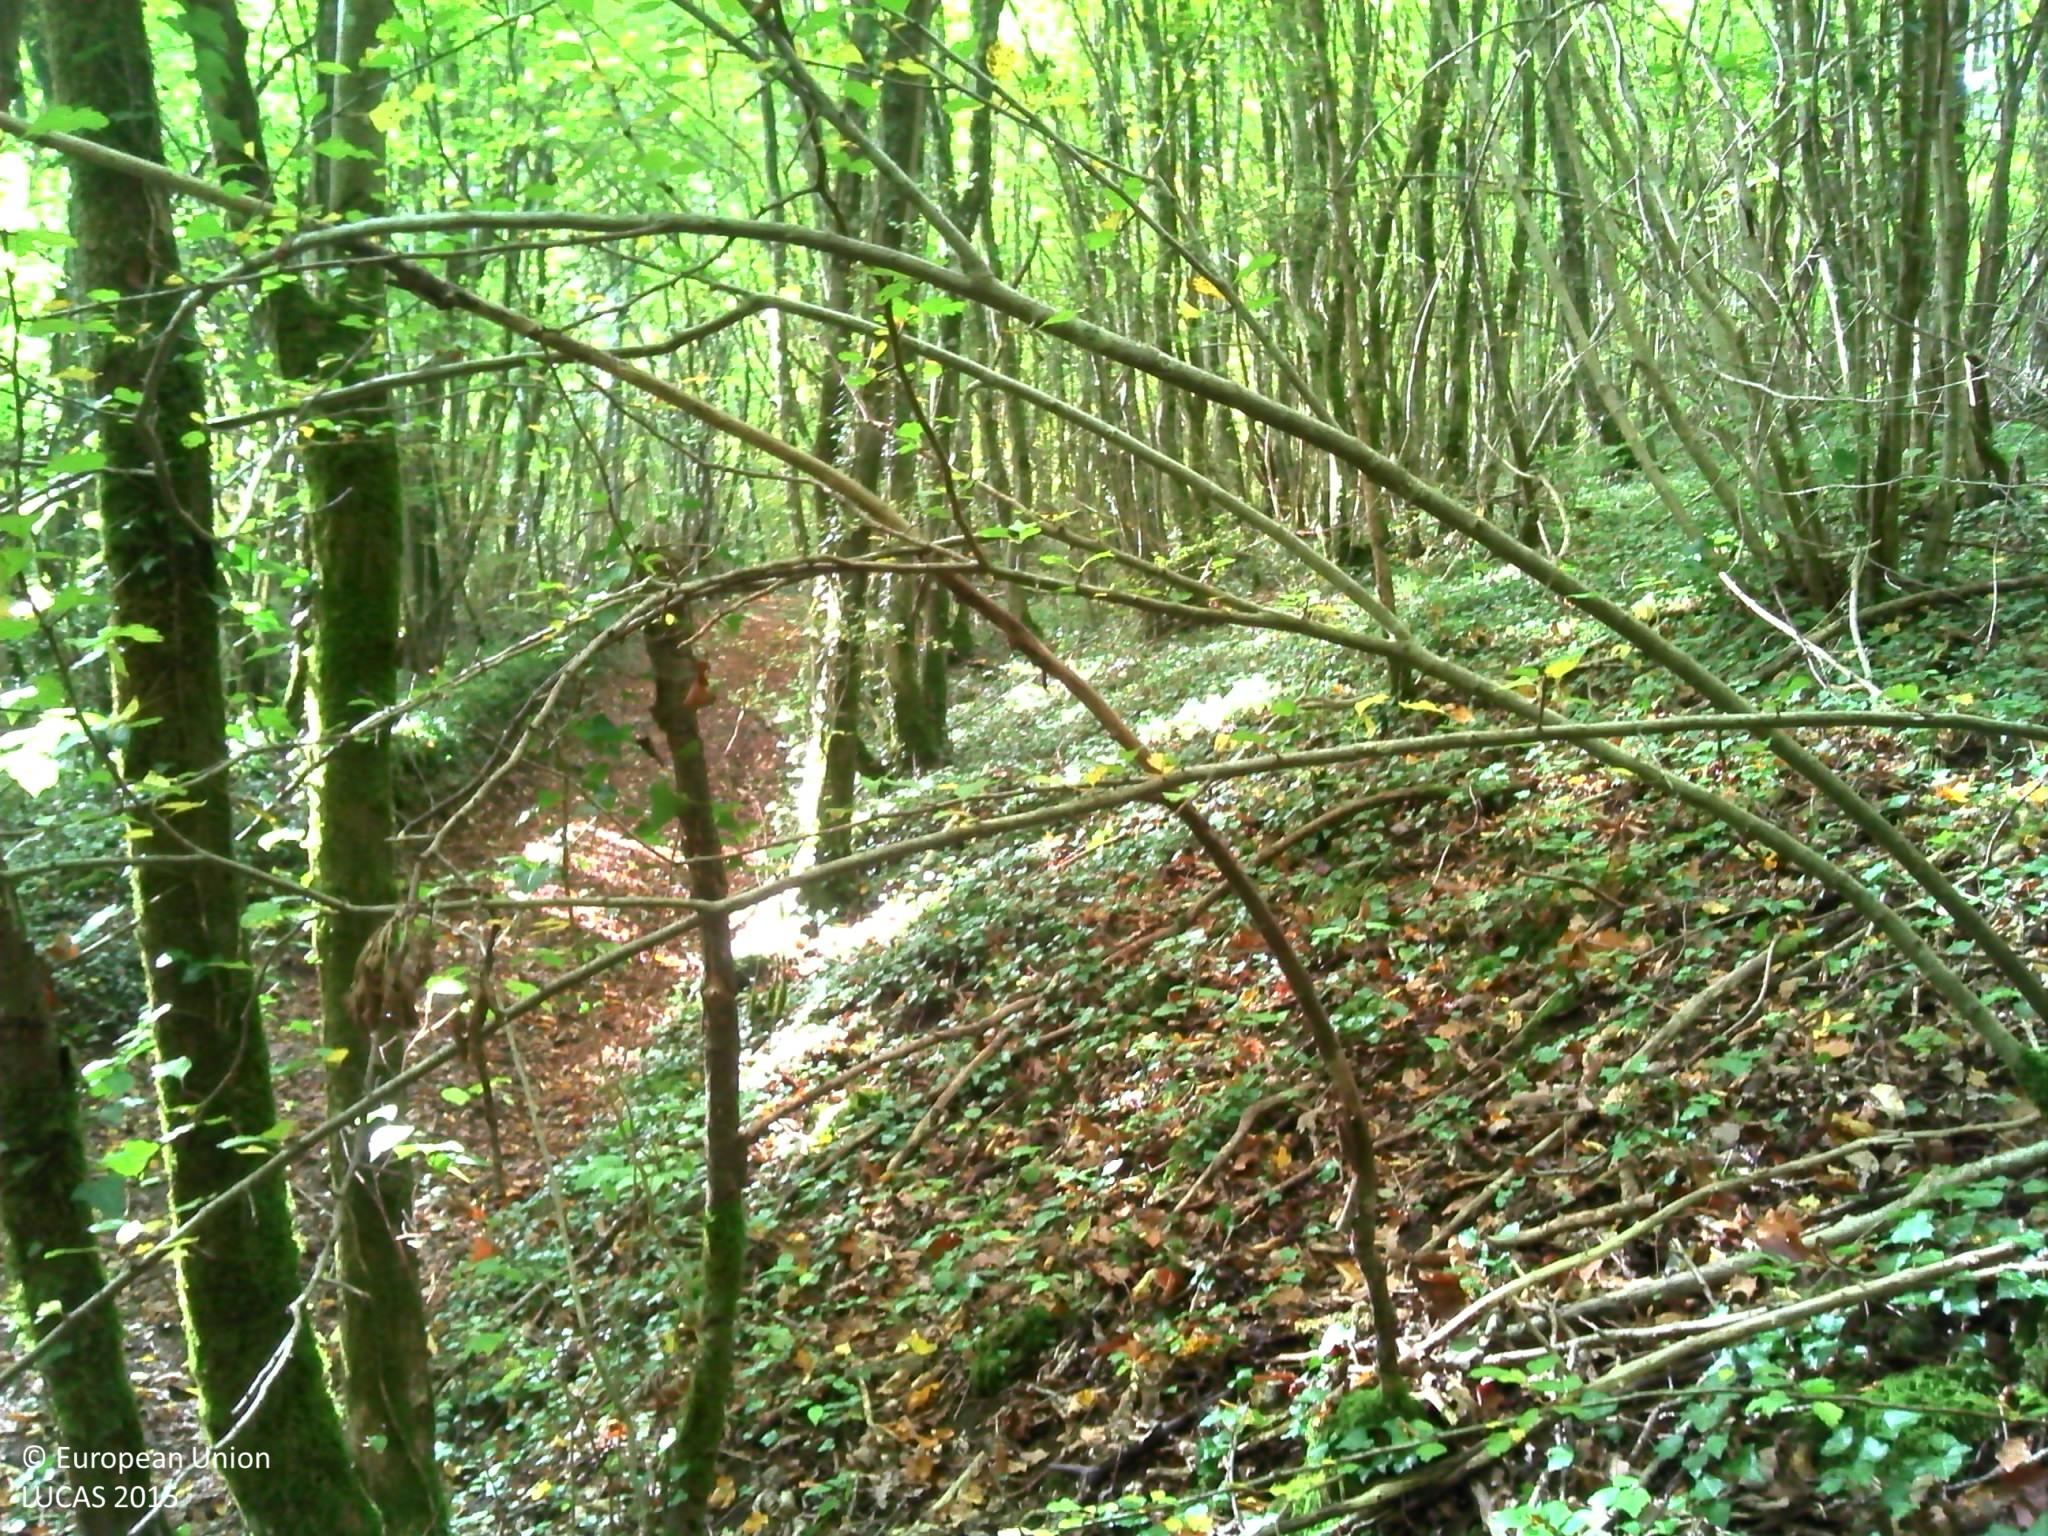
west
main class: Woodland
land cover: Broadleaved woodland
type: mesophytic deciduous forest
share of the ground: > 75 %
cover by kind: broadleaved forest trees 90 %, herbaceous plants 10 %
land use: Forestry
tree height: > 5 m
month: October
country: FR
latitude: 49.6062
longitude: 5.0019
